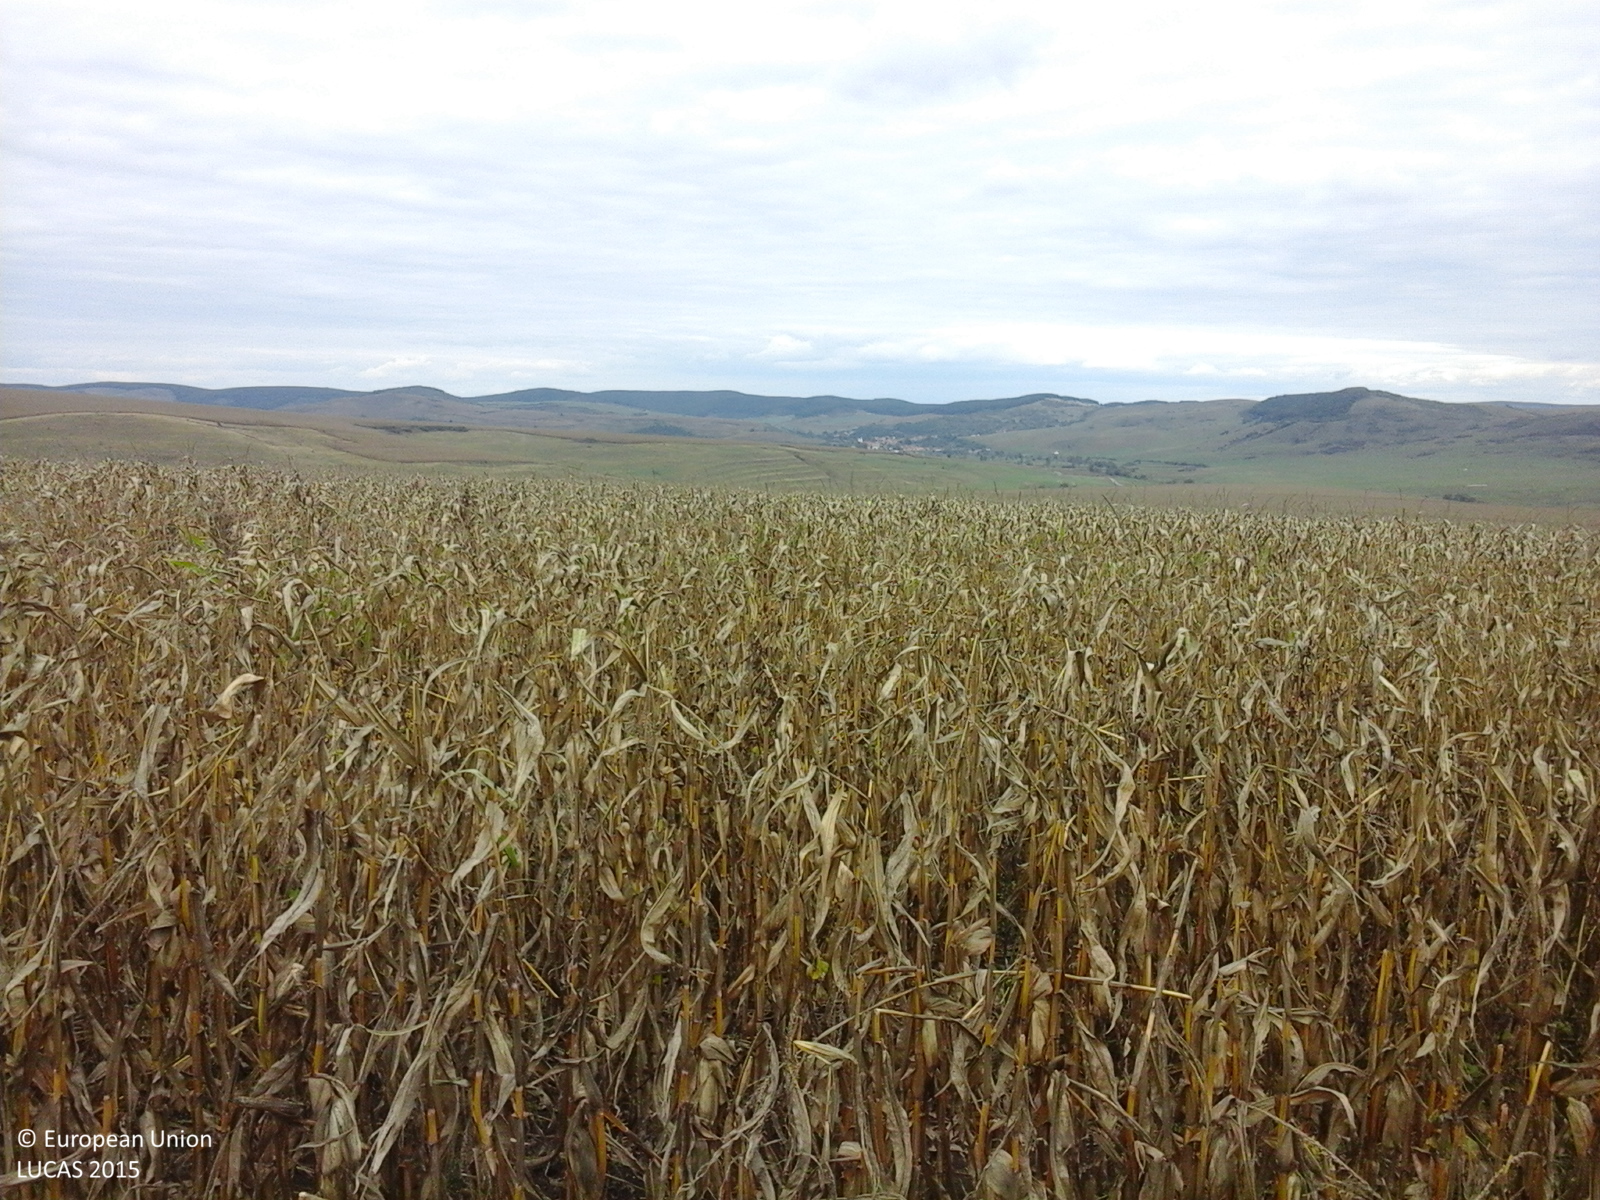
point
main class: Cropland
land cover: Maize
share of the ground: > 75 %
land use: Agriculture (excluding fallow land and kitchen gardens)
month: September
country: RO
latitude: 45.9536
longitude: 23.7311
